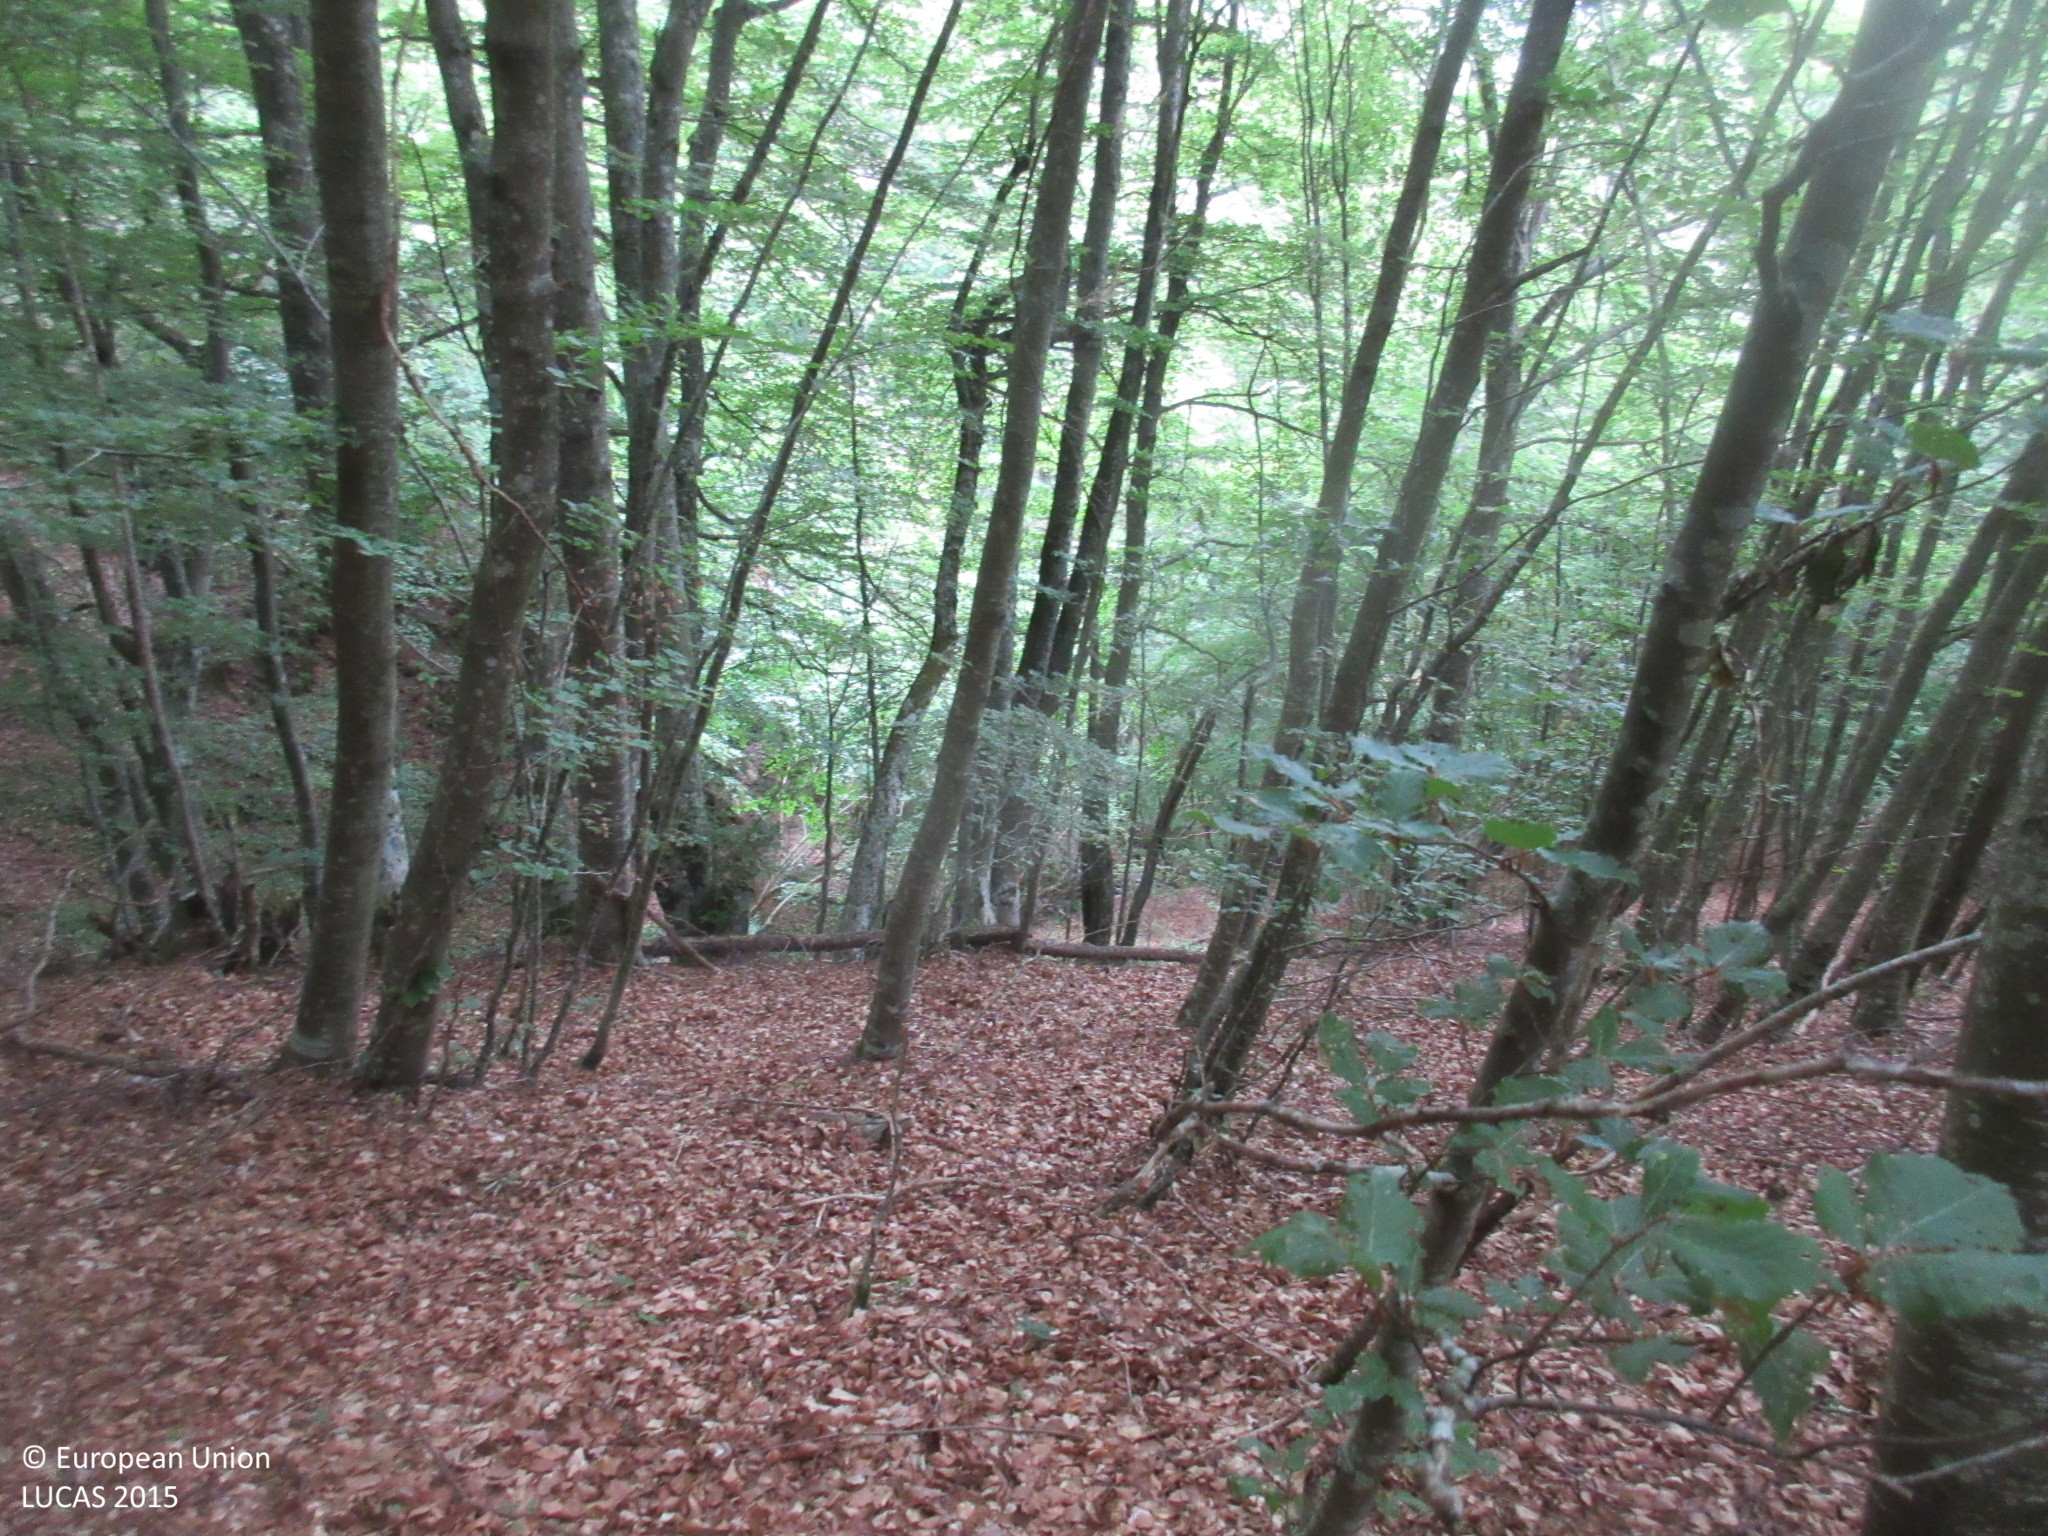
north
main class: Woodland
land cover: Broadleaved woodland
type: beech forest
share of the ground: > 75 %
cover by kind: broadleaved forest trees 100 %
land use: Semi-natural and natural areas not in use
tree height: > 5 m
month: June
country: ES
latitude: 43.0678
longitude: -4.5112
